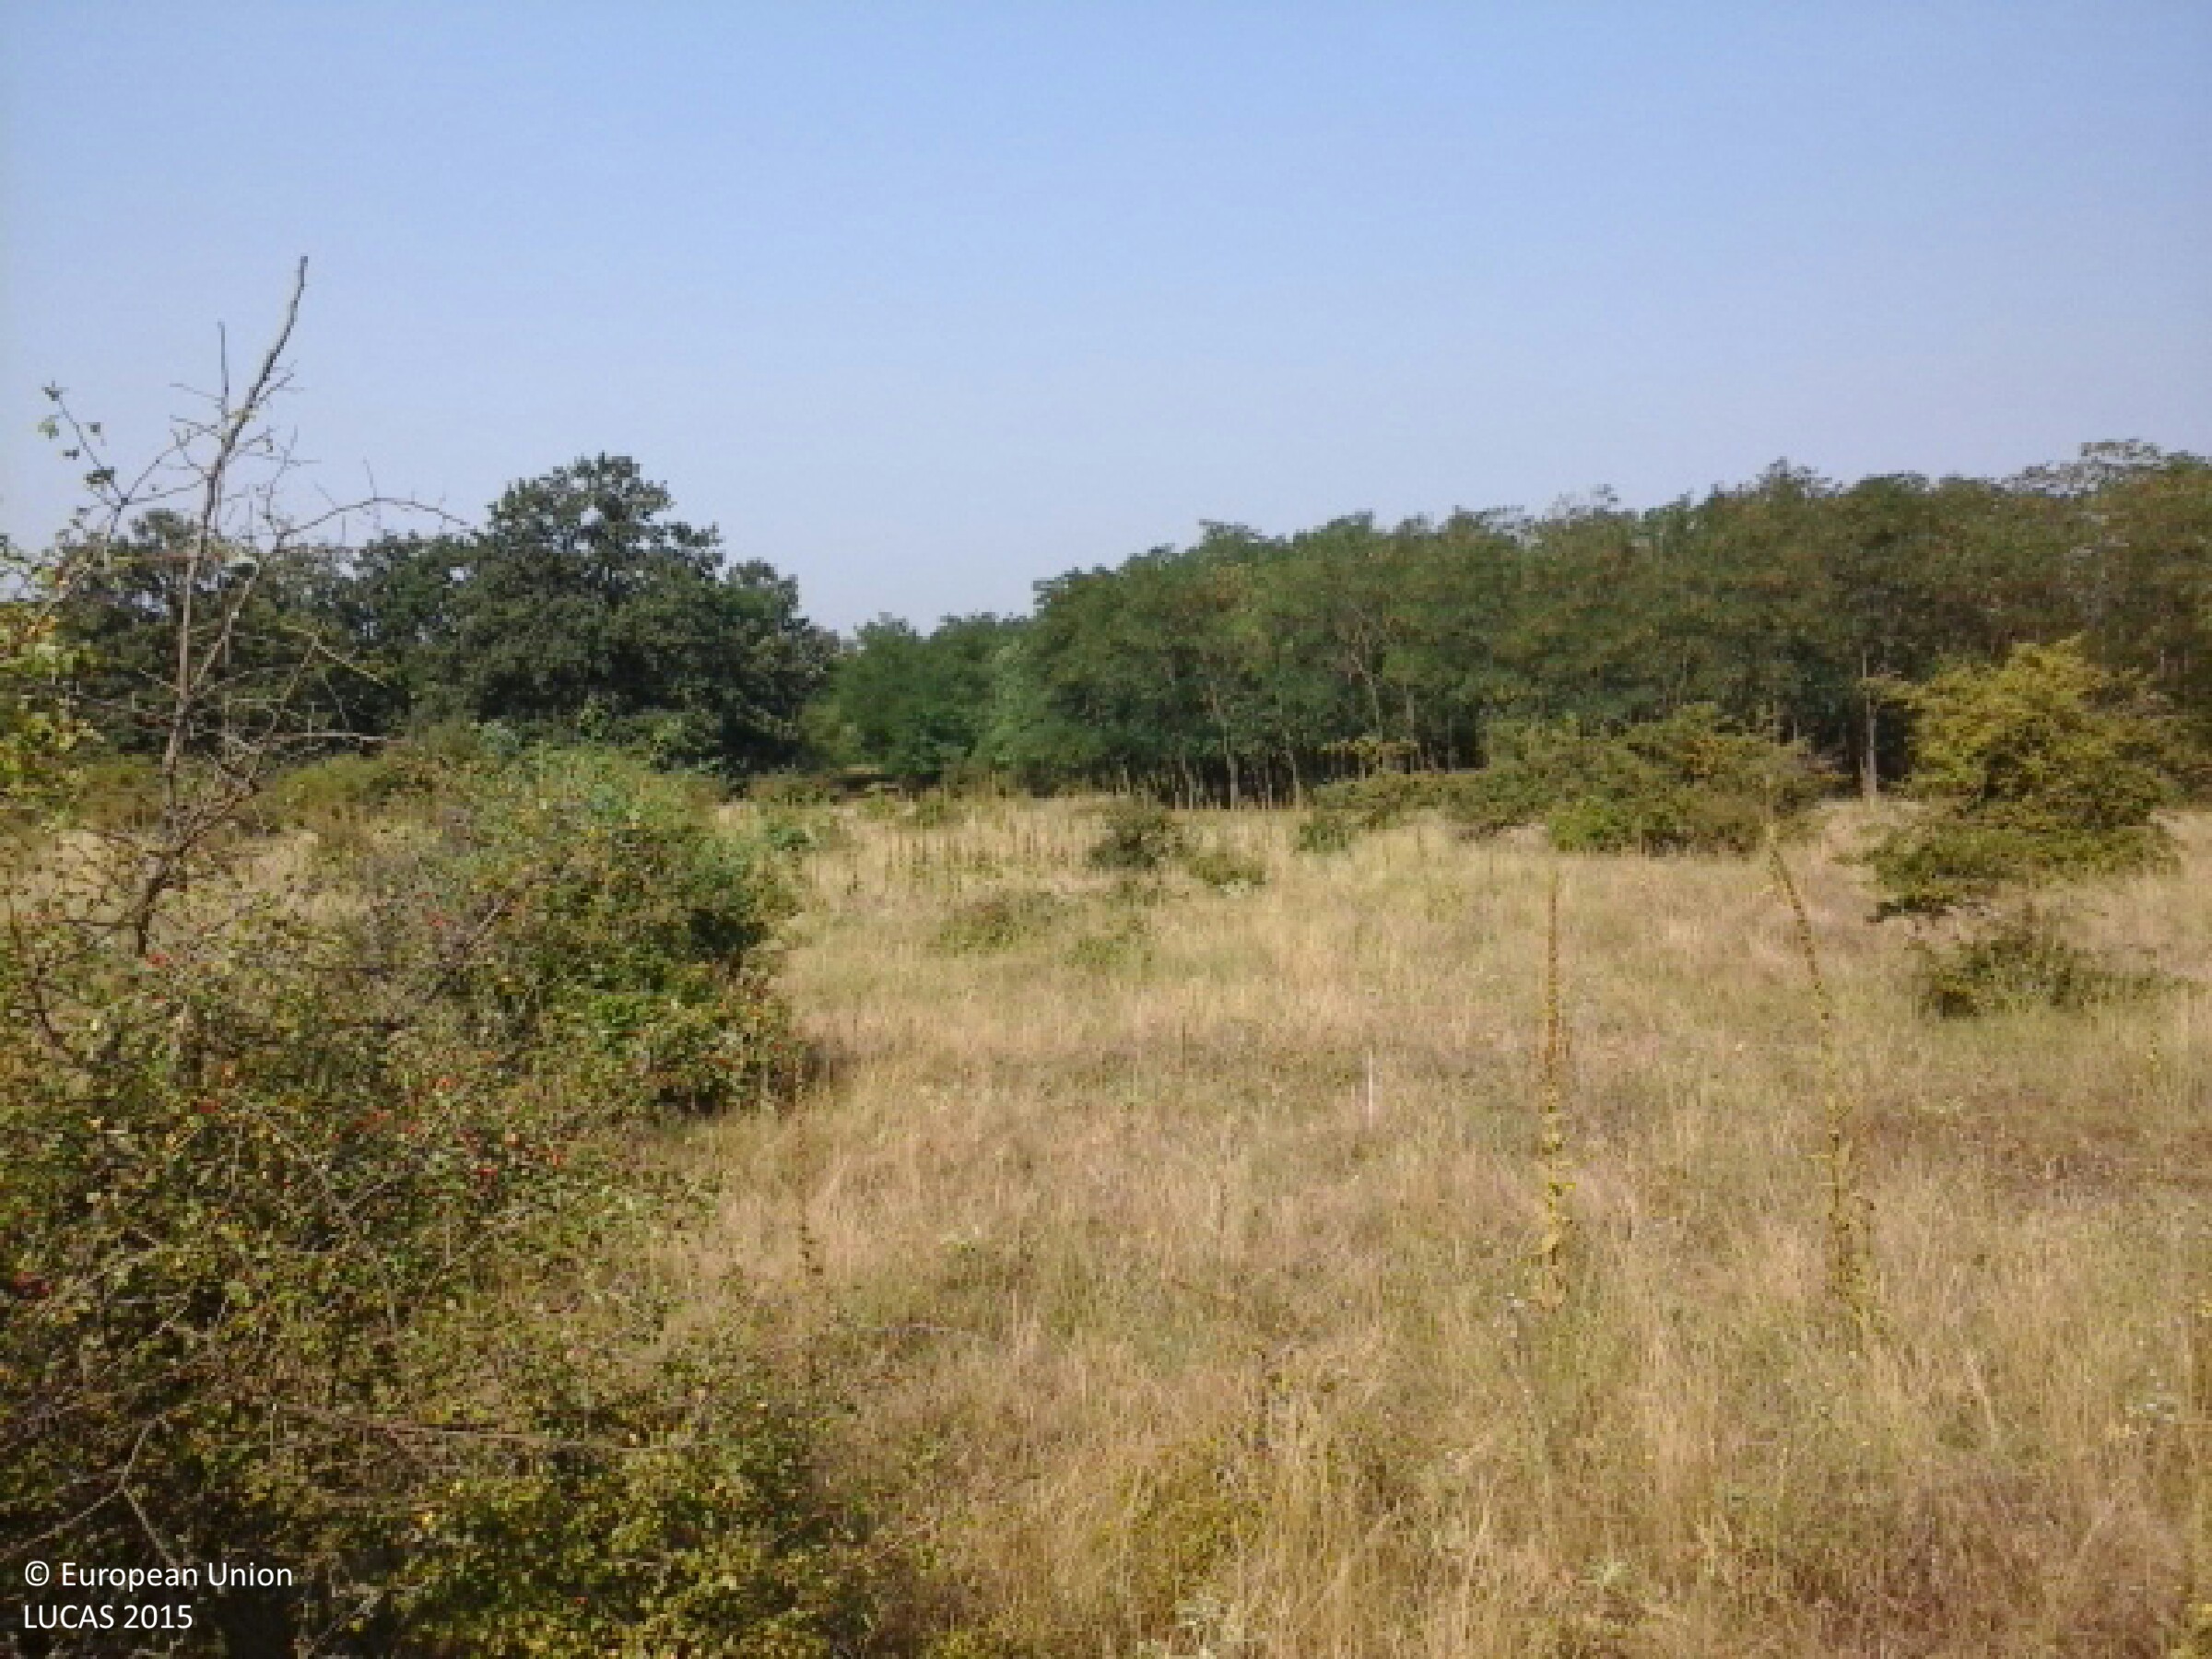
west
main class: Grassland
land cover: Grassland with sparse tree/shrub cover
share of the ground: > 75 %
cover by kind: herbaceous plants 90 %, broadleaved forest trees 5 %, shrubs 5 %
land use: Semi-natural and natural areas not in use
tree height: < 5 m
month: August
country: HU
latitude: 47.2249
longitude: 18.5048
